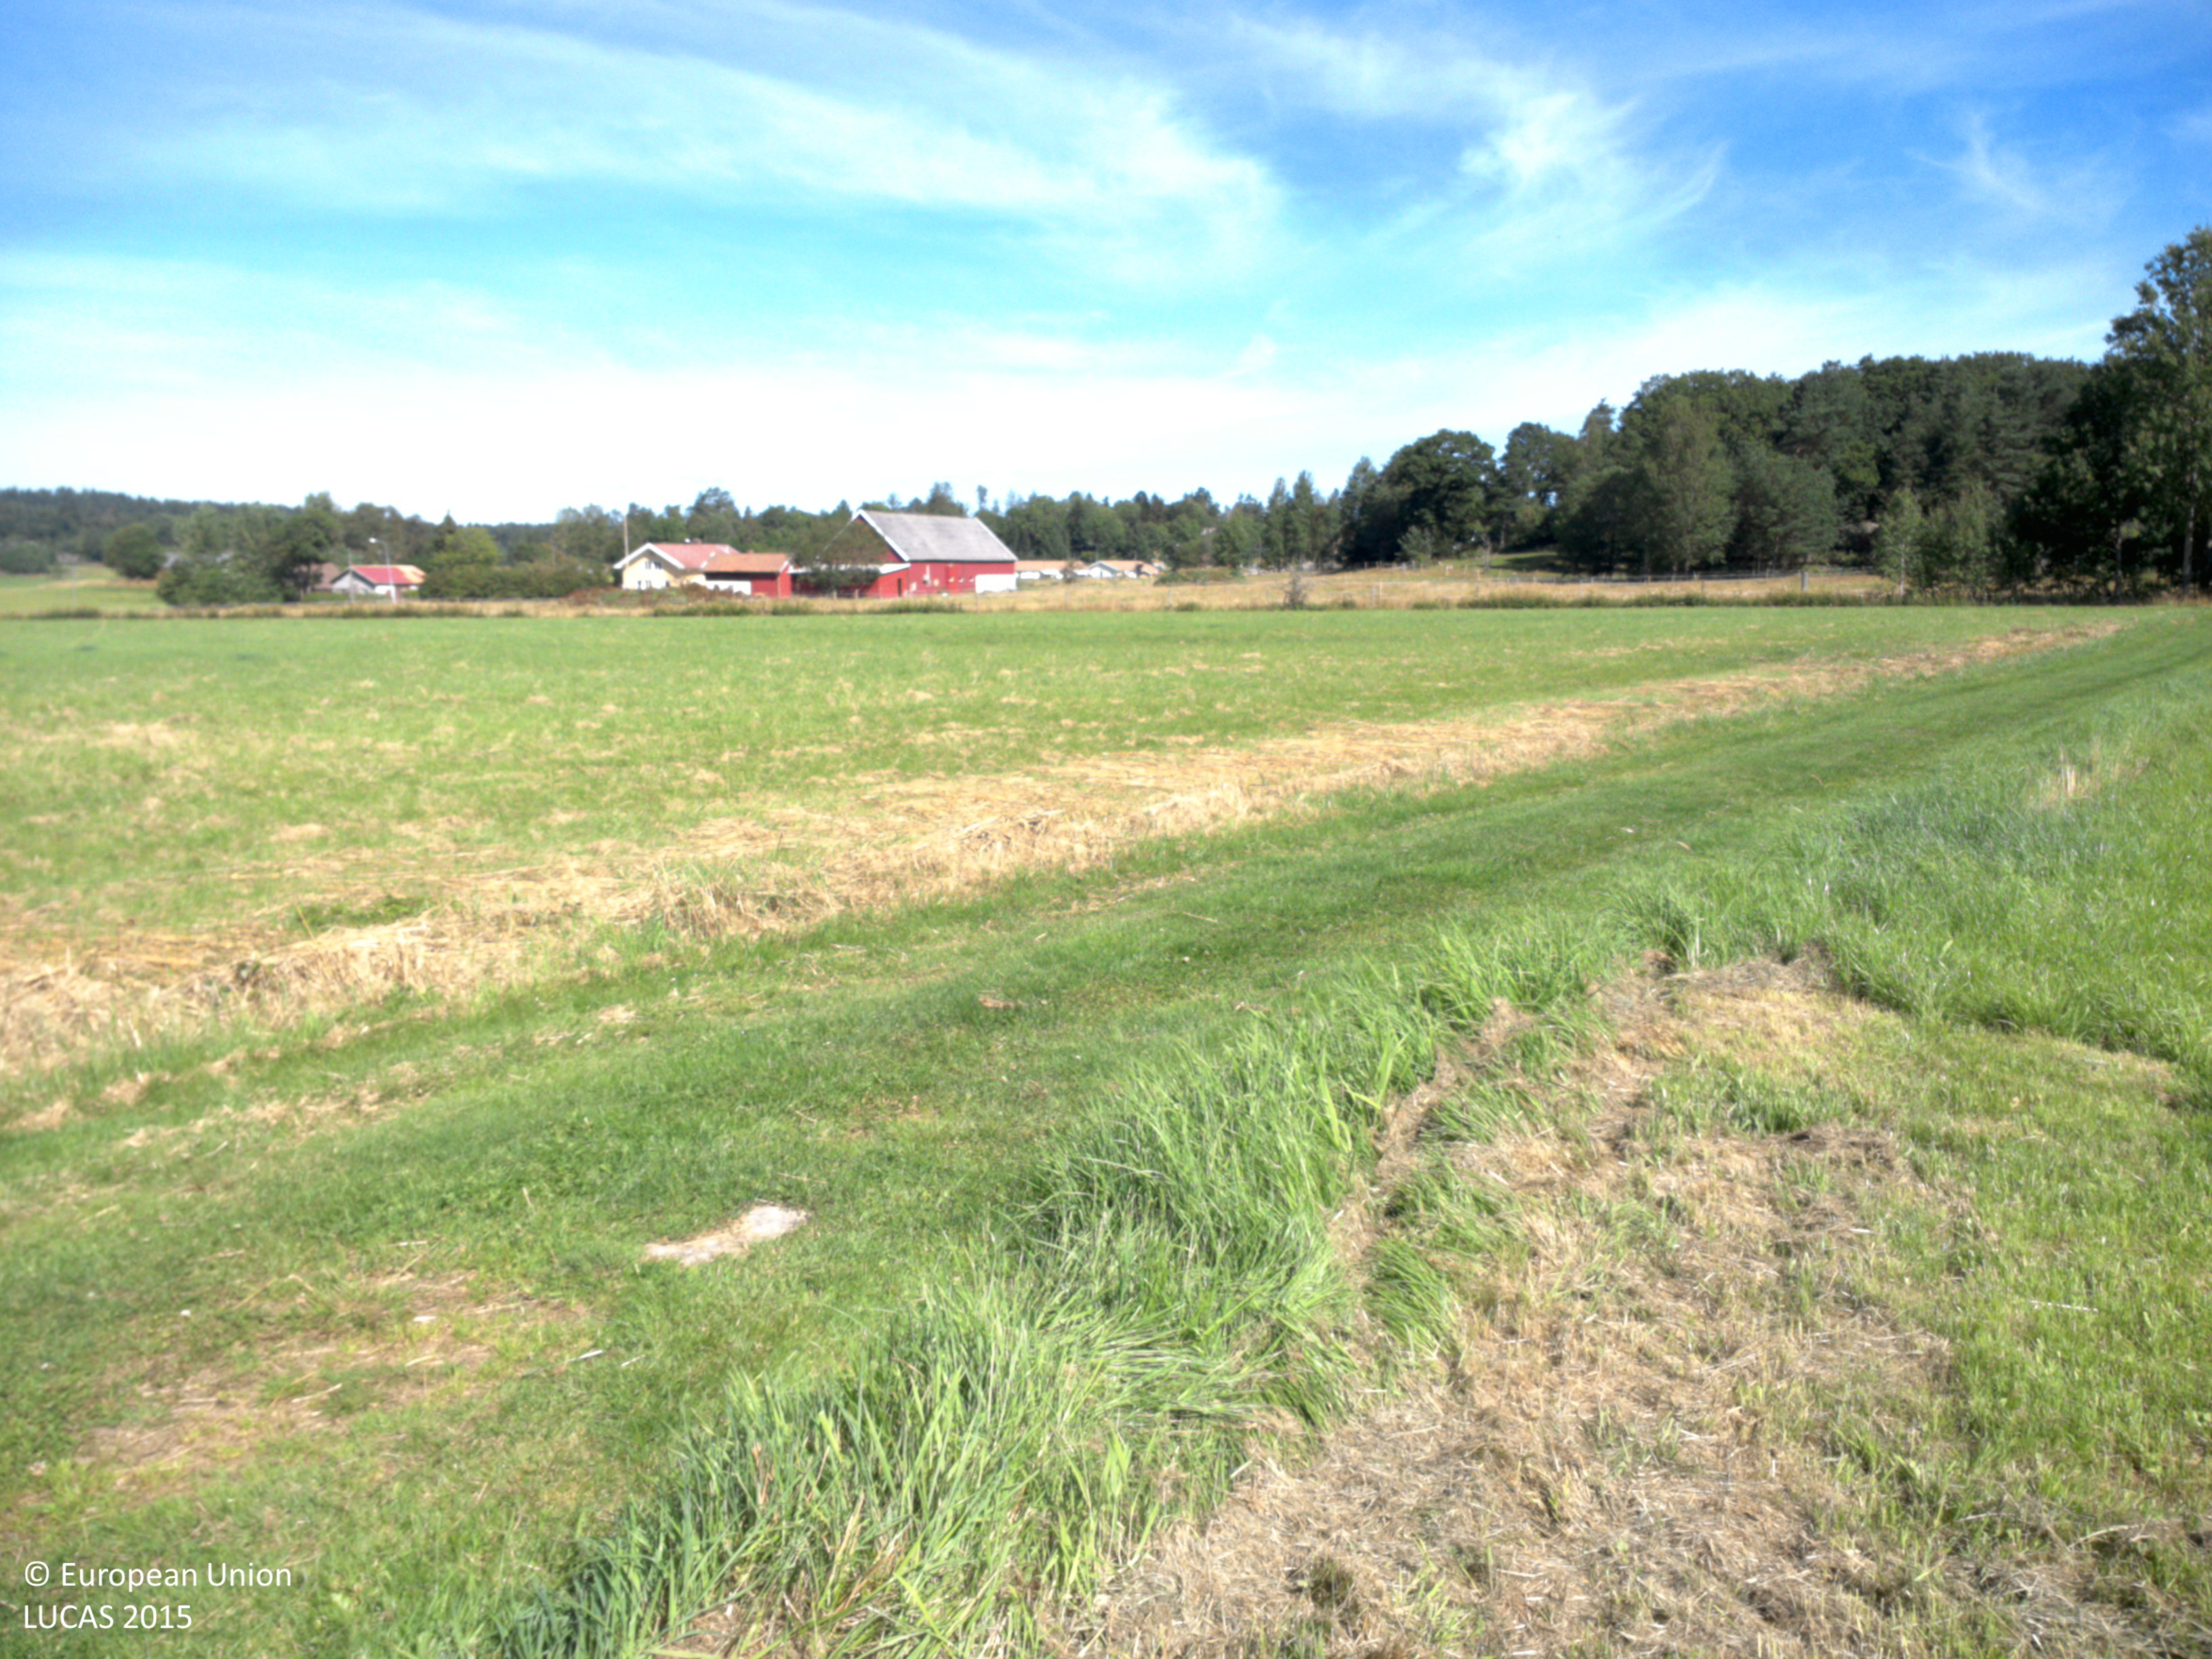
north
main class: Grassland
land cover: Spontaneously vegetated surfaces
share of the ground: > 75 %
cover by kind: herbaceous plants 100 %
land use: Agriculture (excluding fallow land and kitchen gardens)
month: August
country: SE
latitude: 58.0382
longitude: 12.2825
